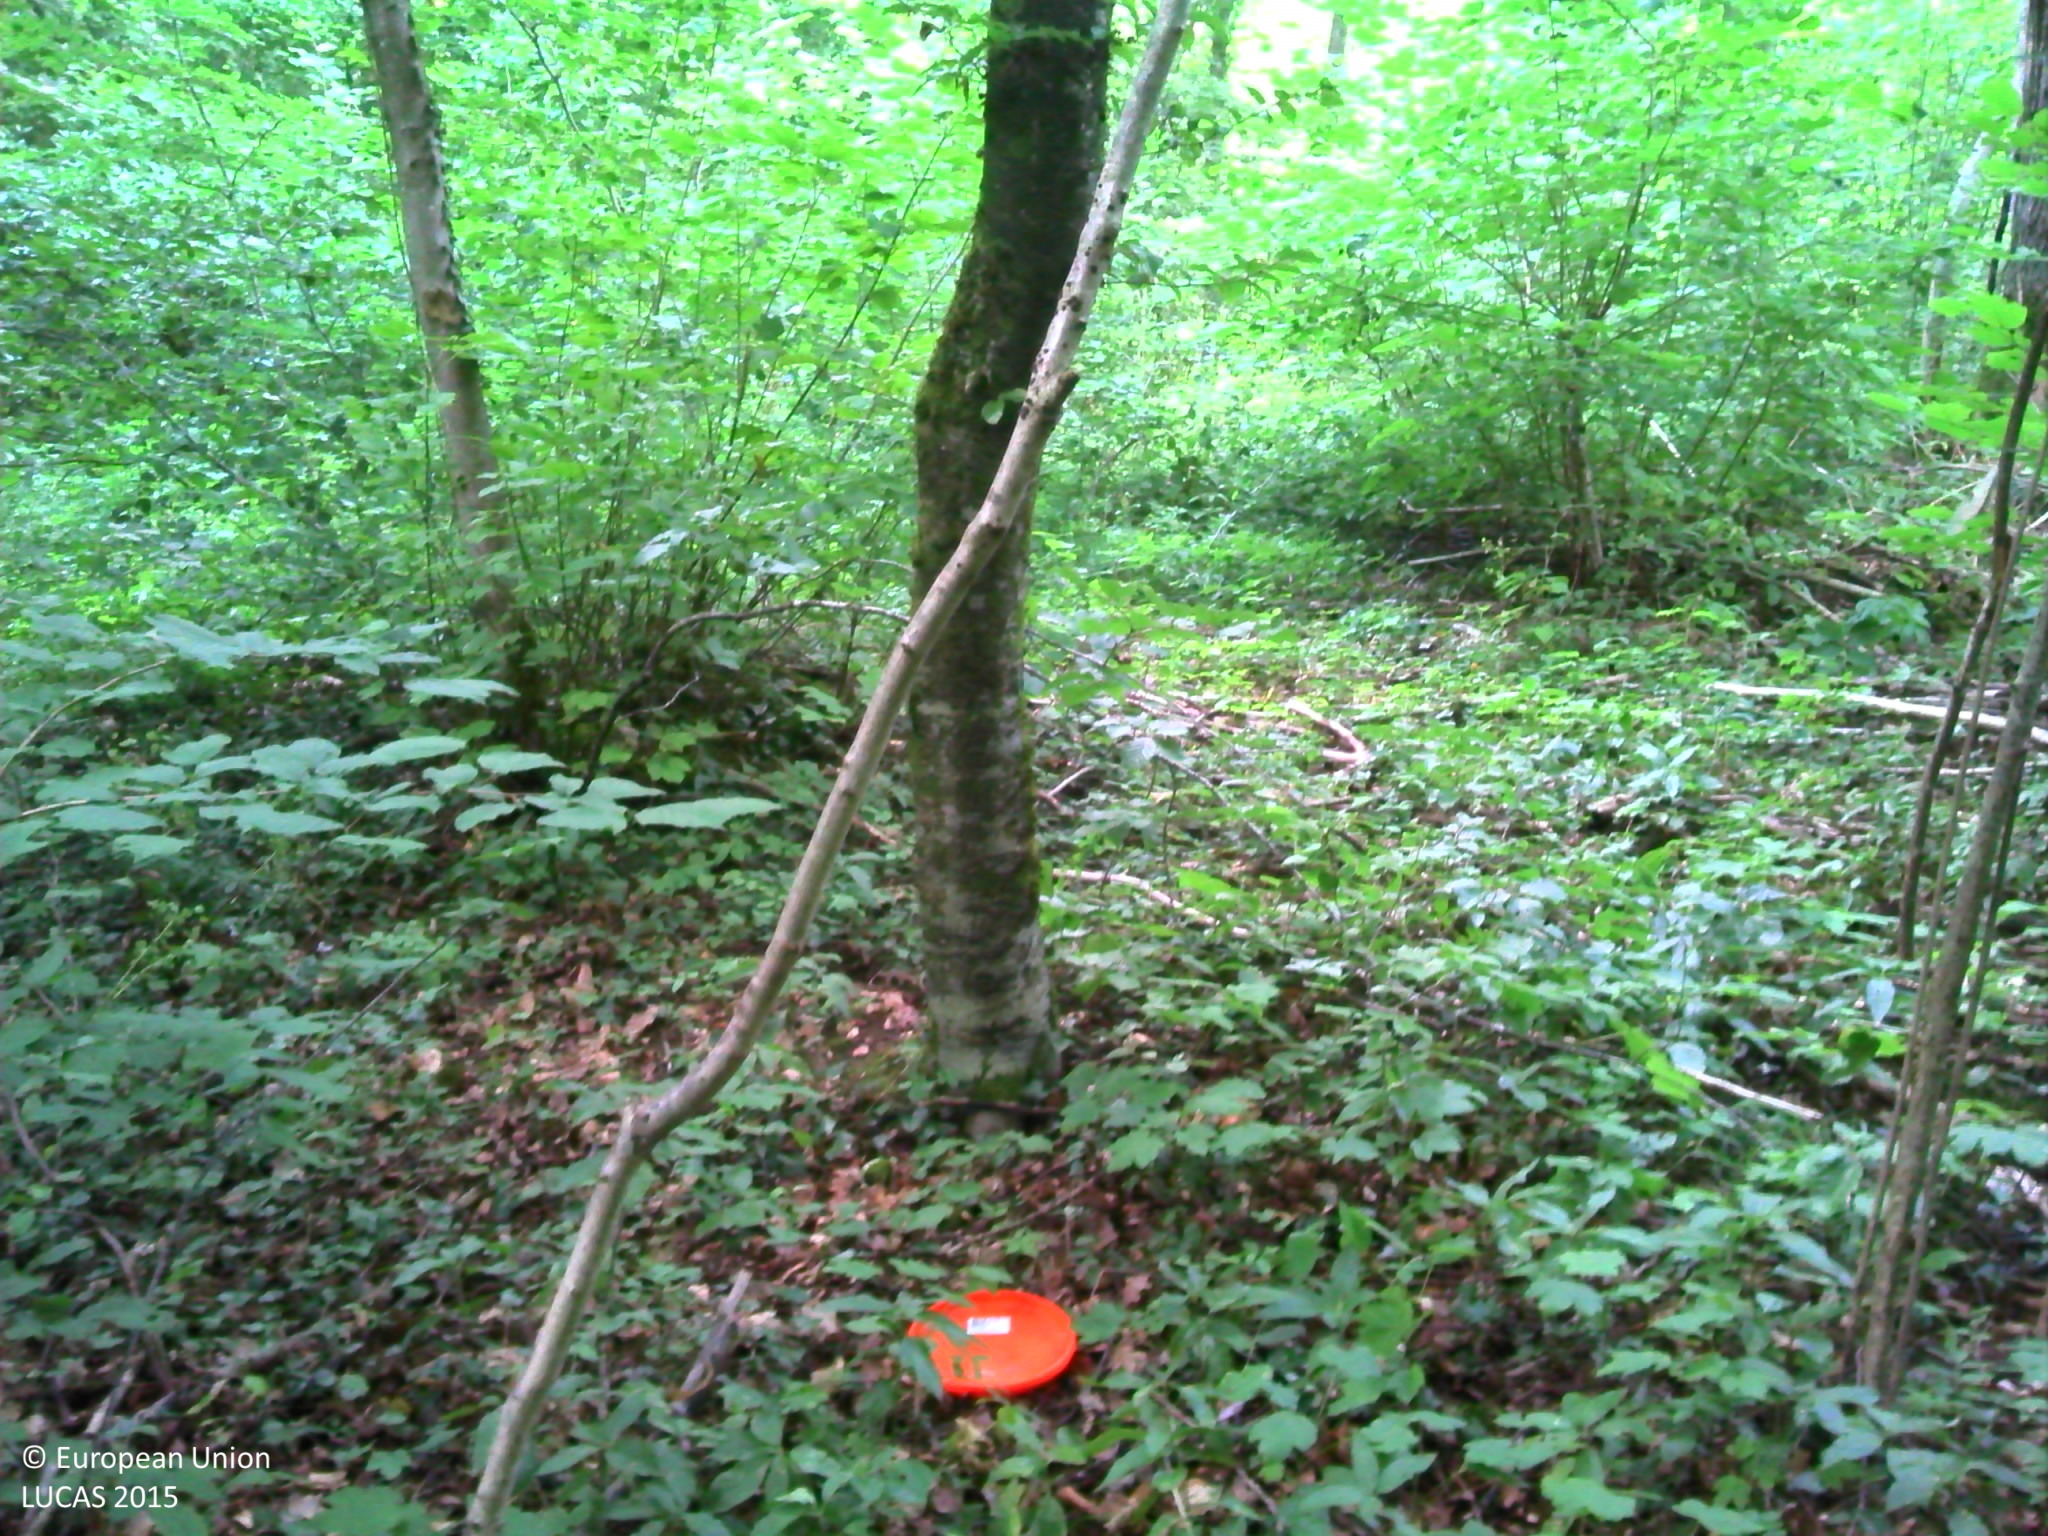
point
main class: Woodland
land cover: Broadleaved woodland
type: mesophytic deciduous forest
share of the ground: > 75 %
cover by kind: broadleaved forest trees 95 %, shrubs 5 %
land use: Forestry
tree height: > 5 m
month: July
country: BE
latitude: 49.5238
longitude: 5.6195
